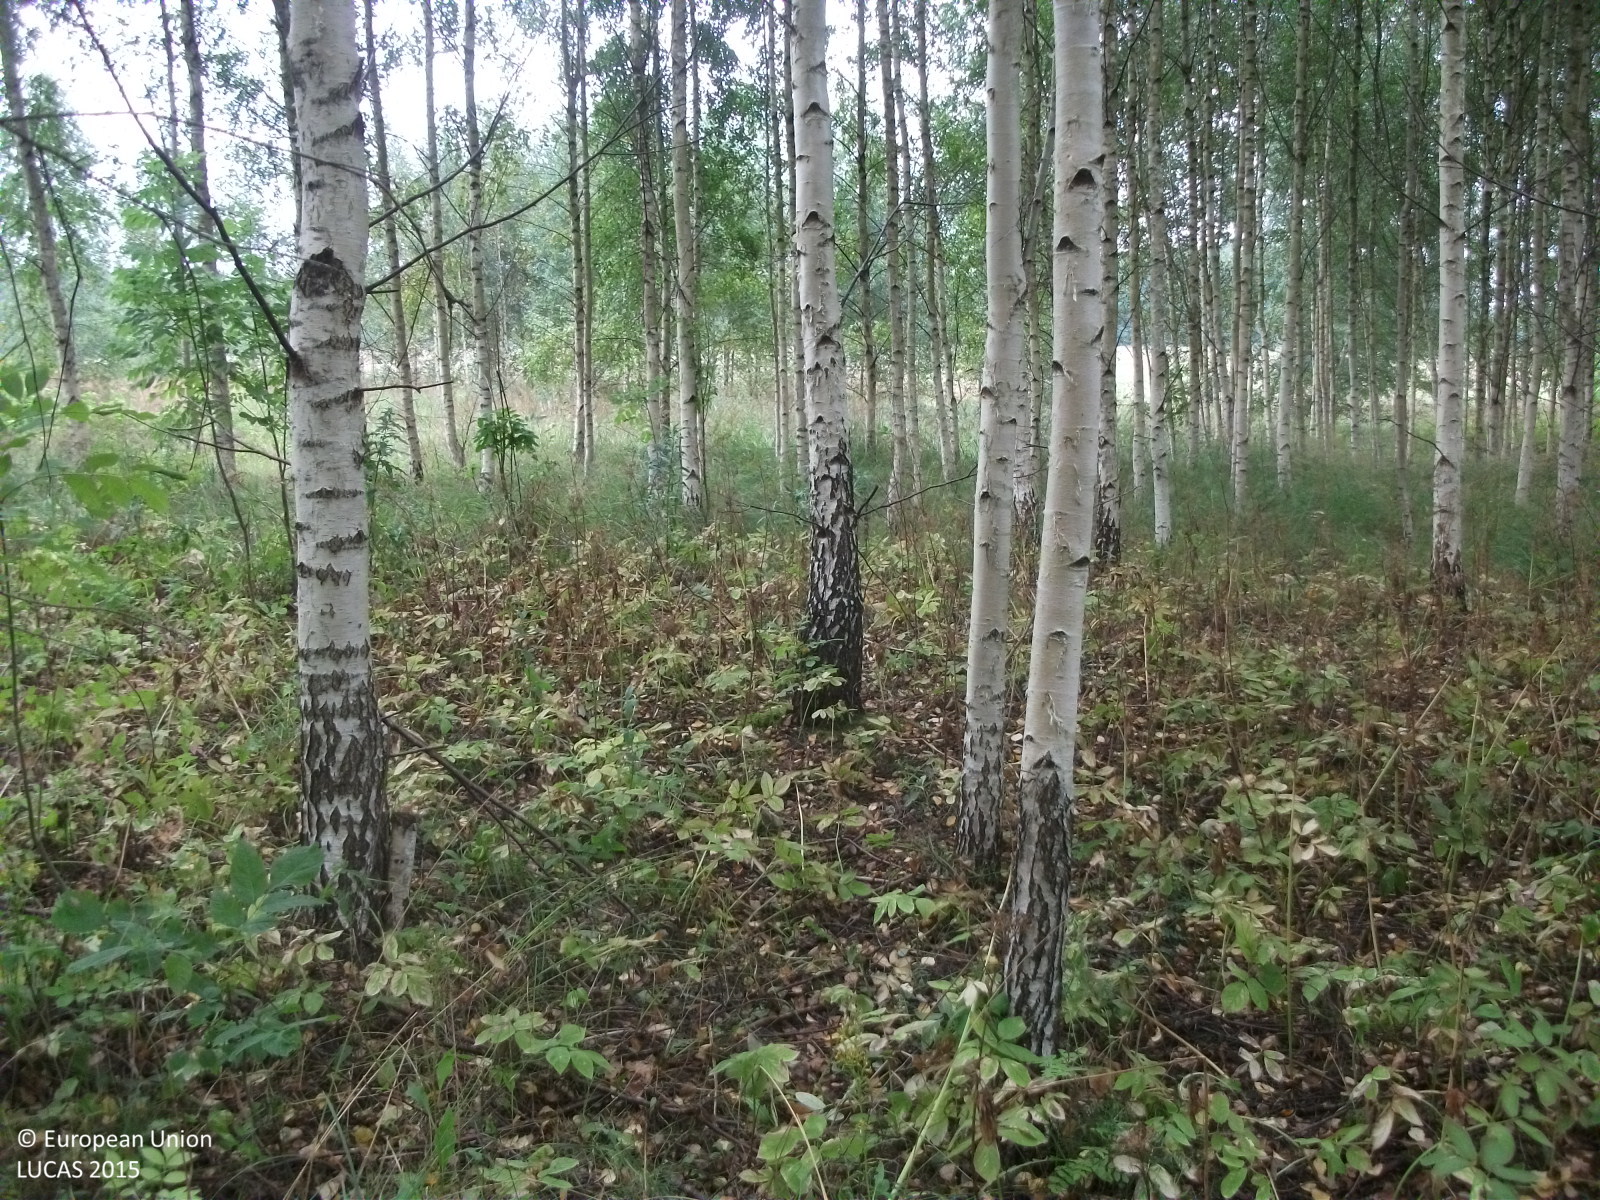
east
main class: Woodland
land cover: Broadleaved woodland
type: non-riverine alder, birch or aspen forest
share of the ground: 50 - 75 %
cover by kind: broadleaved forest trees 60 %, herbaceous plants 30 %, shrubs 10 %
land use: Forestry
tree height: > 5 m
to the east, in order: Broadleaved woodland; Grassland without tree/shrub cover; Spruce dominated coniferous woodland; Shruby margins; Rape and turnip rape; Shruby margins; Tracks; Shruby margins; Rape and turnip rape
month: September
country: LV
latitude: 57.4757
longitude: 24.7211
